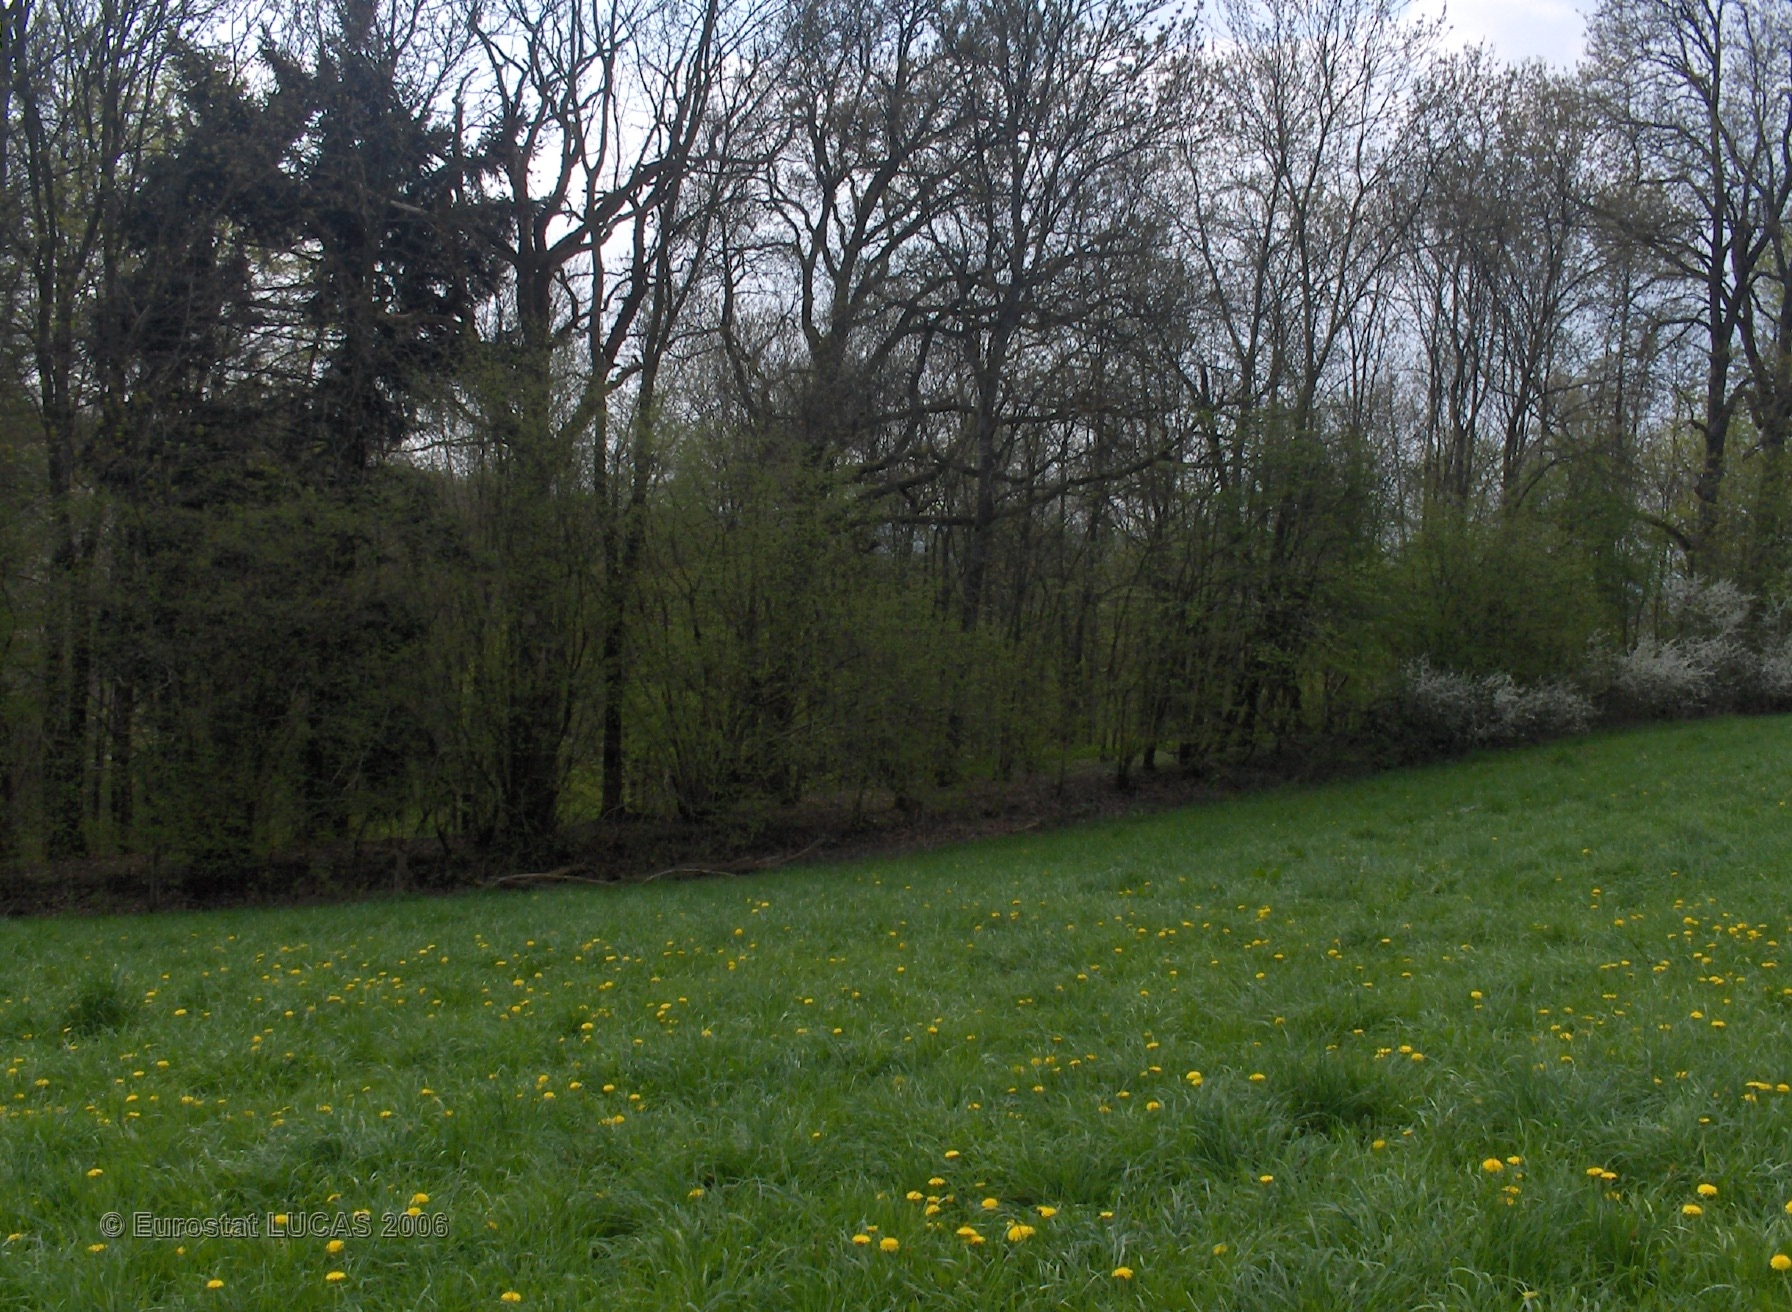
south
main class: Grassland
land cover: Grassland without tree/shrub cover
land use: Agriculture (excluding fallow land and kitchen gardens)
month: May
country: BE
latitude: 50.3212
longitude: 5.2927
